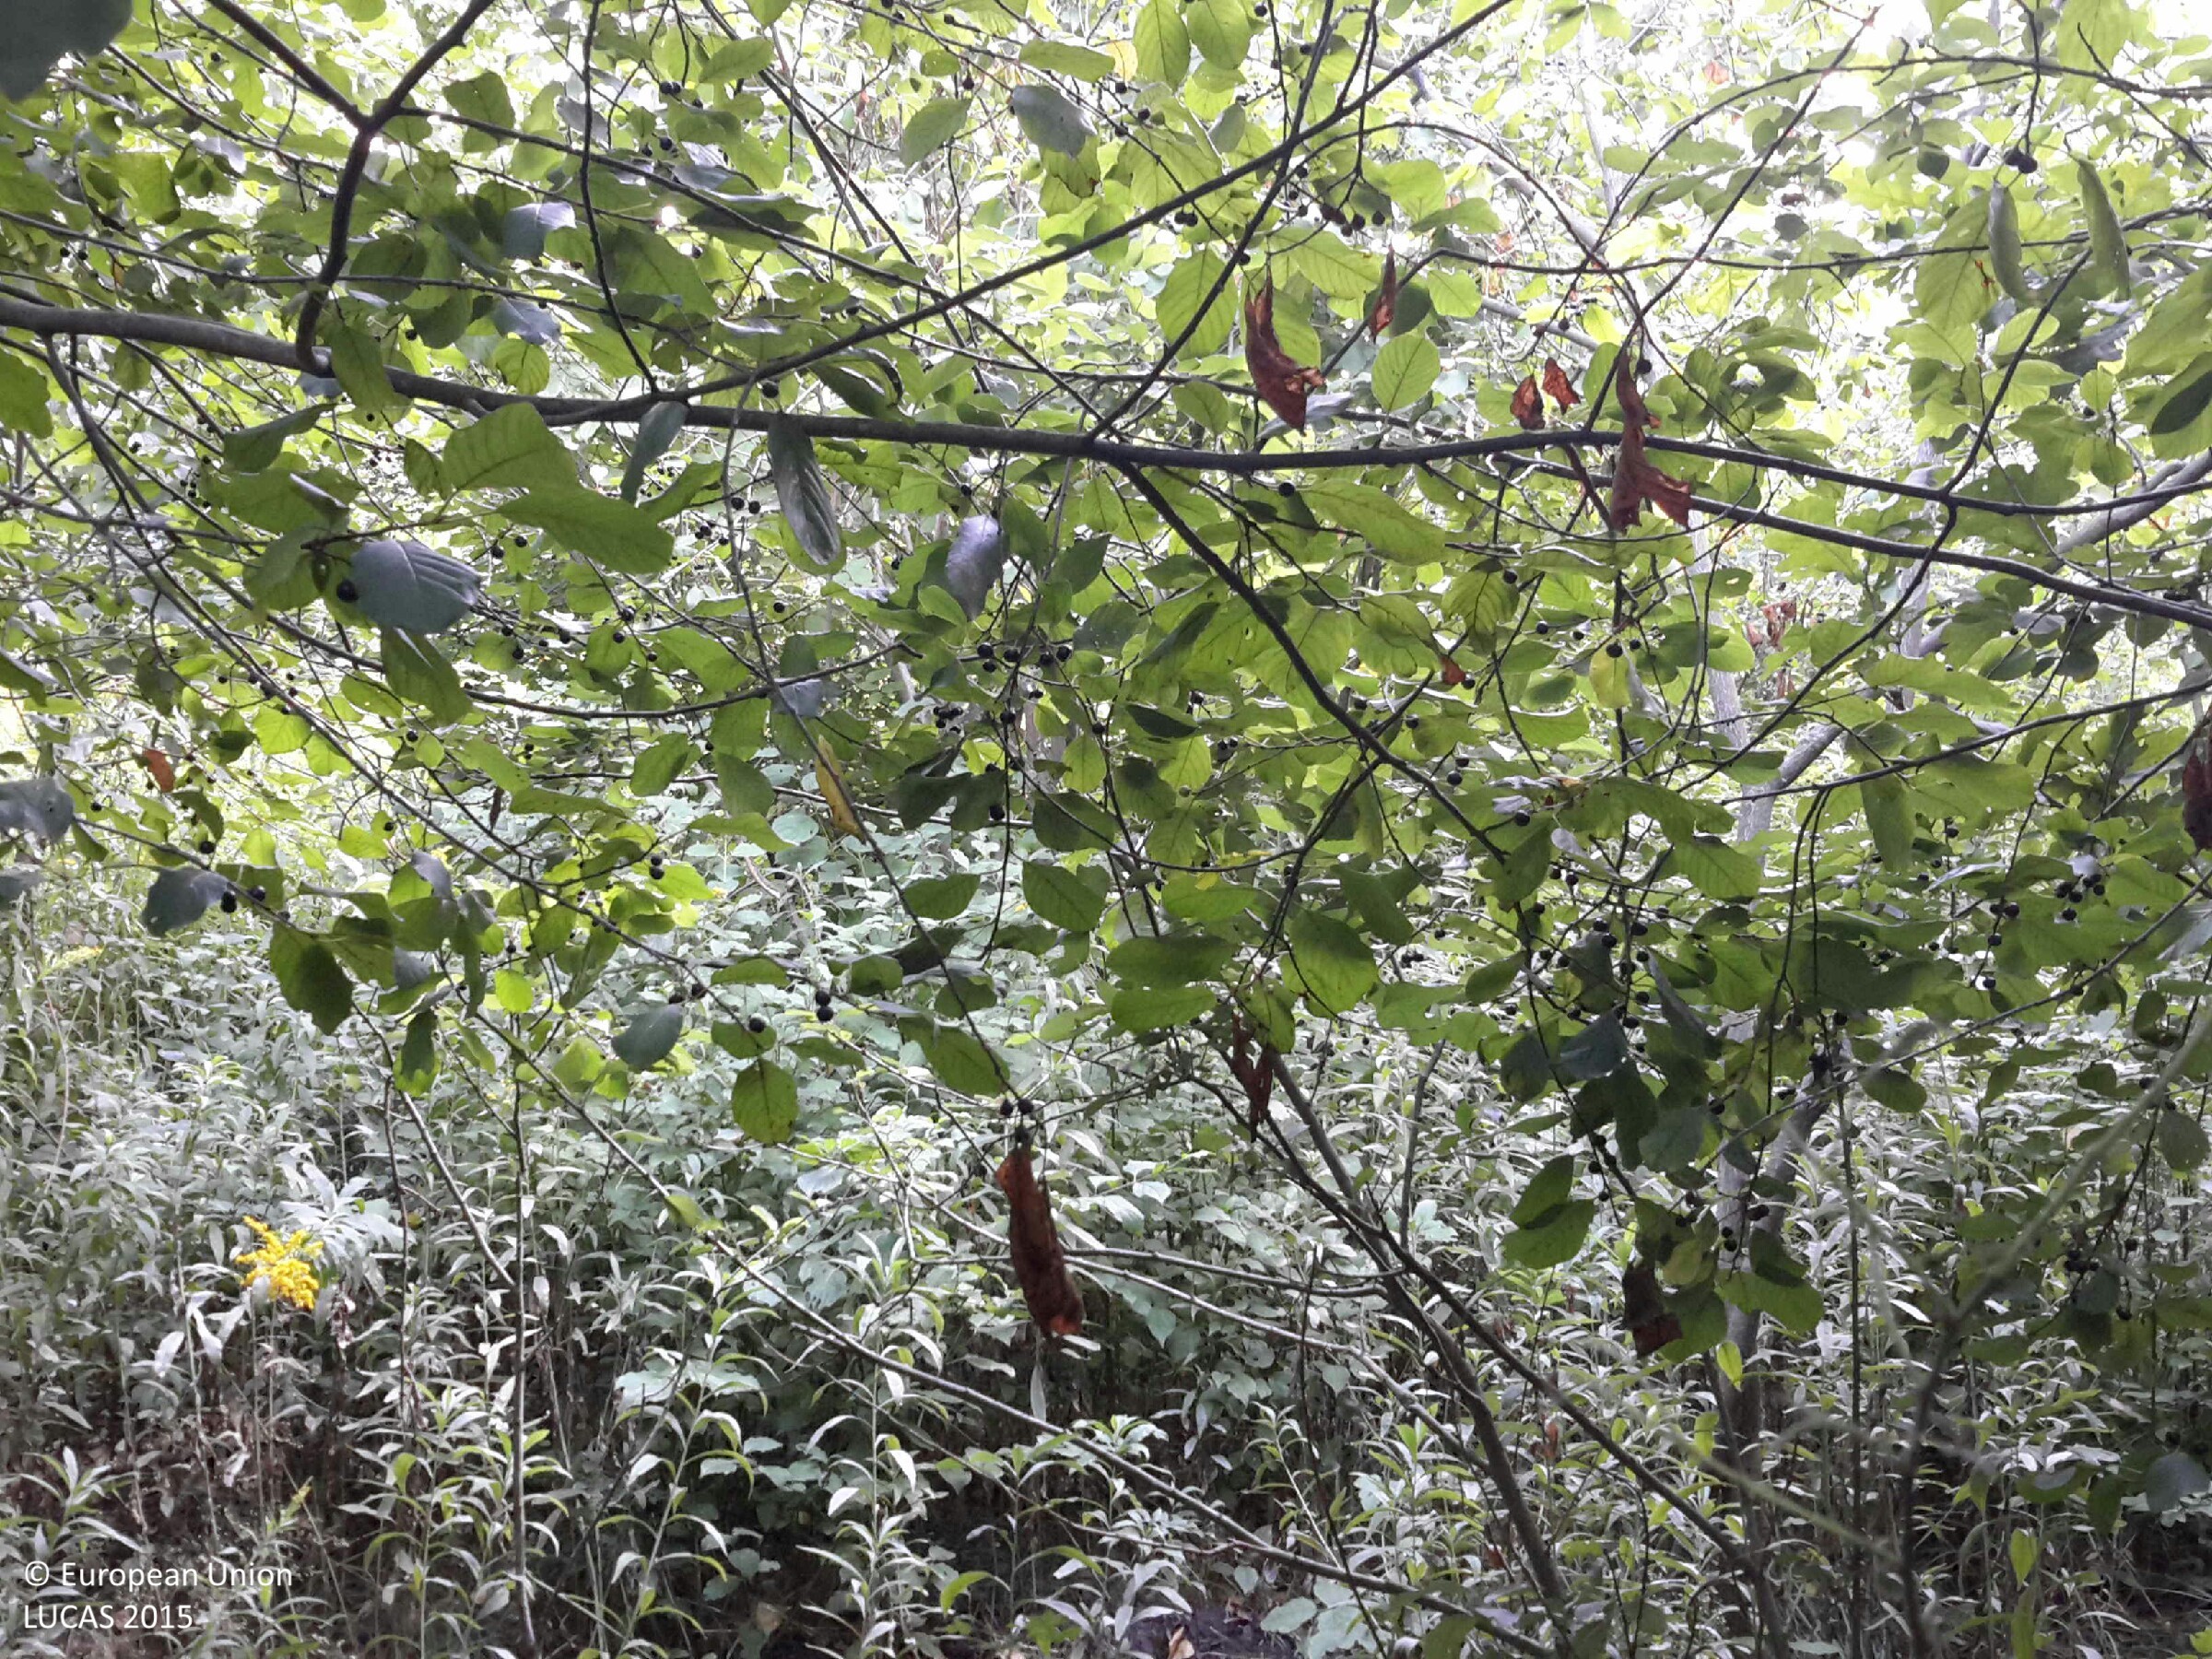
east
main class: Woodland
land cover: Broadleaved woodland
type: thermophilous deciduous forest
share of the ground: > 75 %
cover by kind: broadleaved forest trees 60 %, shrubs 30 %, herbaceous plants 10 %
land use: Forestry
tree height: > 5 m
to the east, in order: Broadleaved woodland; Shrubland with sparse tree cover; Broadleaved woodland; Grassland with sparse tree/shrub cover
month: August
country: HU
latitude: 47.2702
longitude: 17.3956
